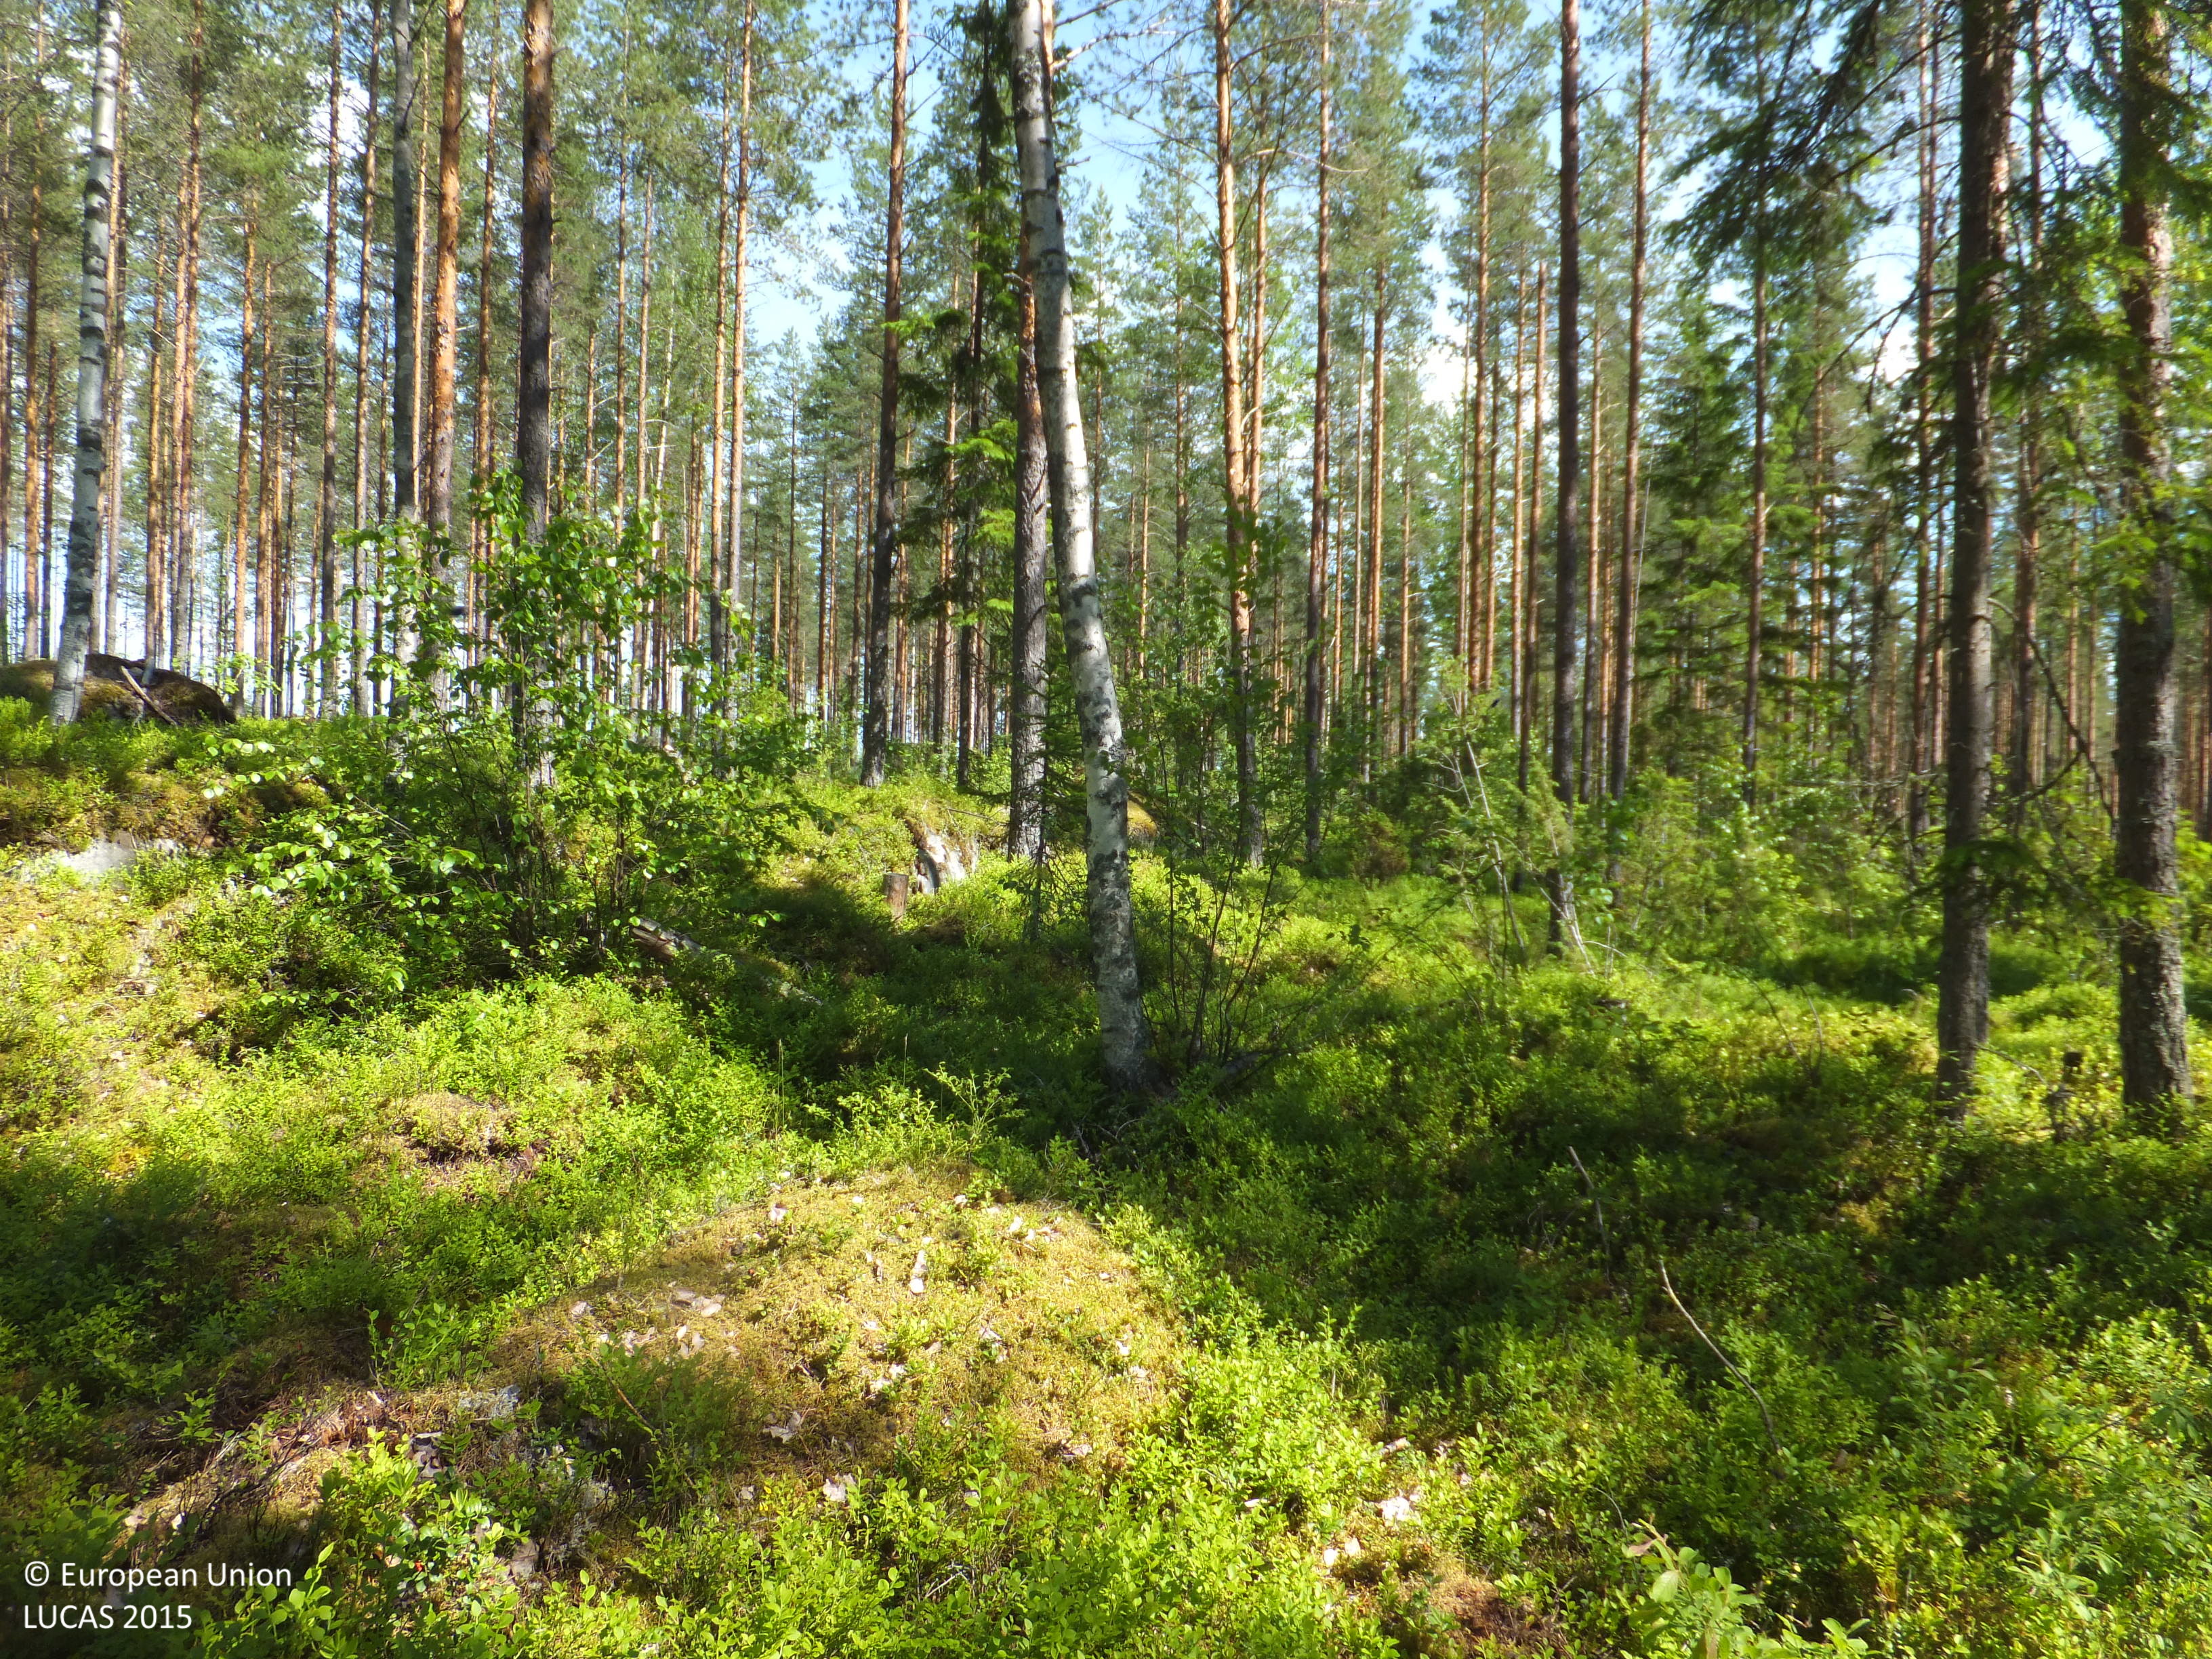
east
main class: Woodland
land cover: Pine dominated mixed woodland
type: boreal forest
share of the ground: 50 - 75 %
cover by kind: coniferous forest trees 40 %, shrubs 25 %, broadleaved forest trees 15 %, lichens and mosses 15 %, consolidated bare surface 5 %
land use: Forestry
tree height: > 5 m
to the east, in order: Pine dominated mixed woodland
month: July
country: FI
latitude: 63.0439
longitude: 23.9349
